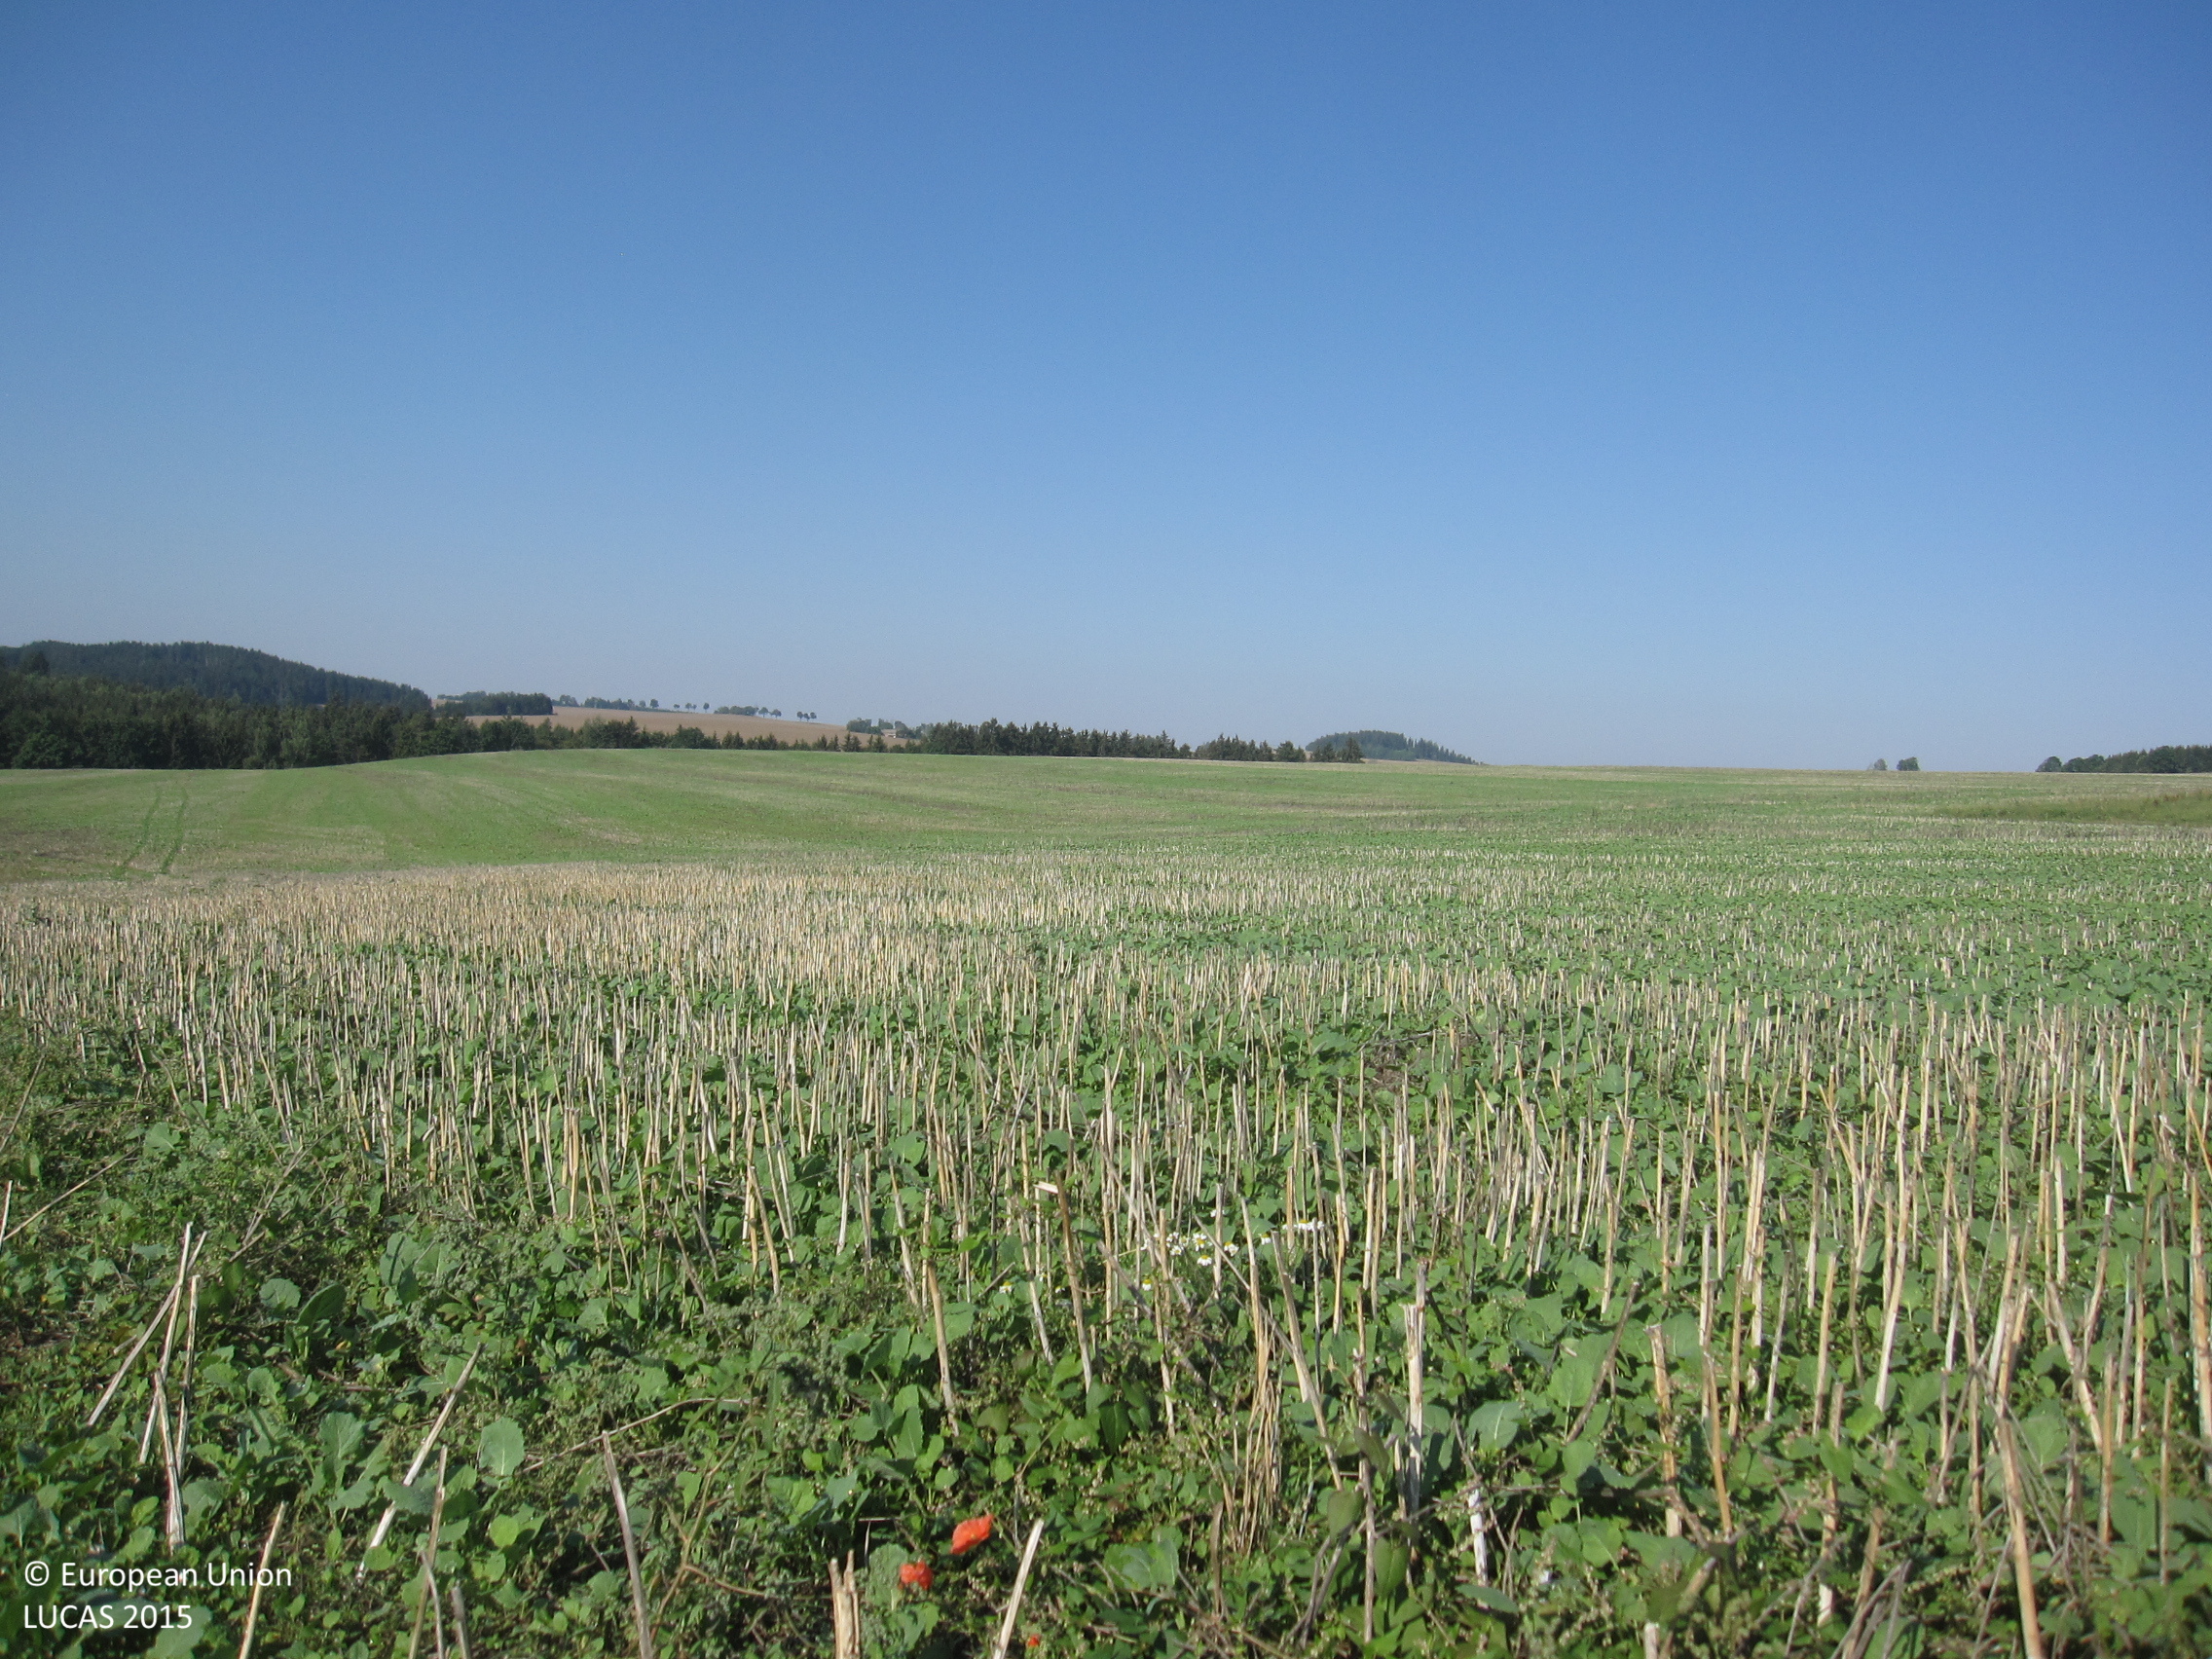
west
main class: Cropland
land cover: Rape and turnip rape
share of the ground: > 75 %
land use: Agriculture (excluding fallow land and kitchen gardens)
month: August
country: DE
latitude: 50.5867
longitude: 11.5957
